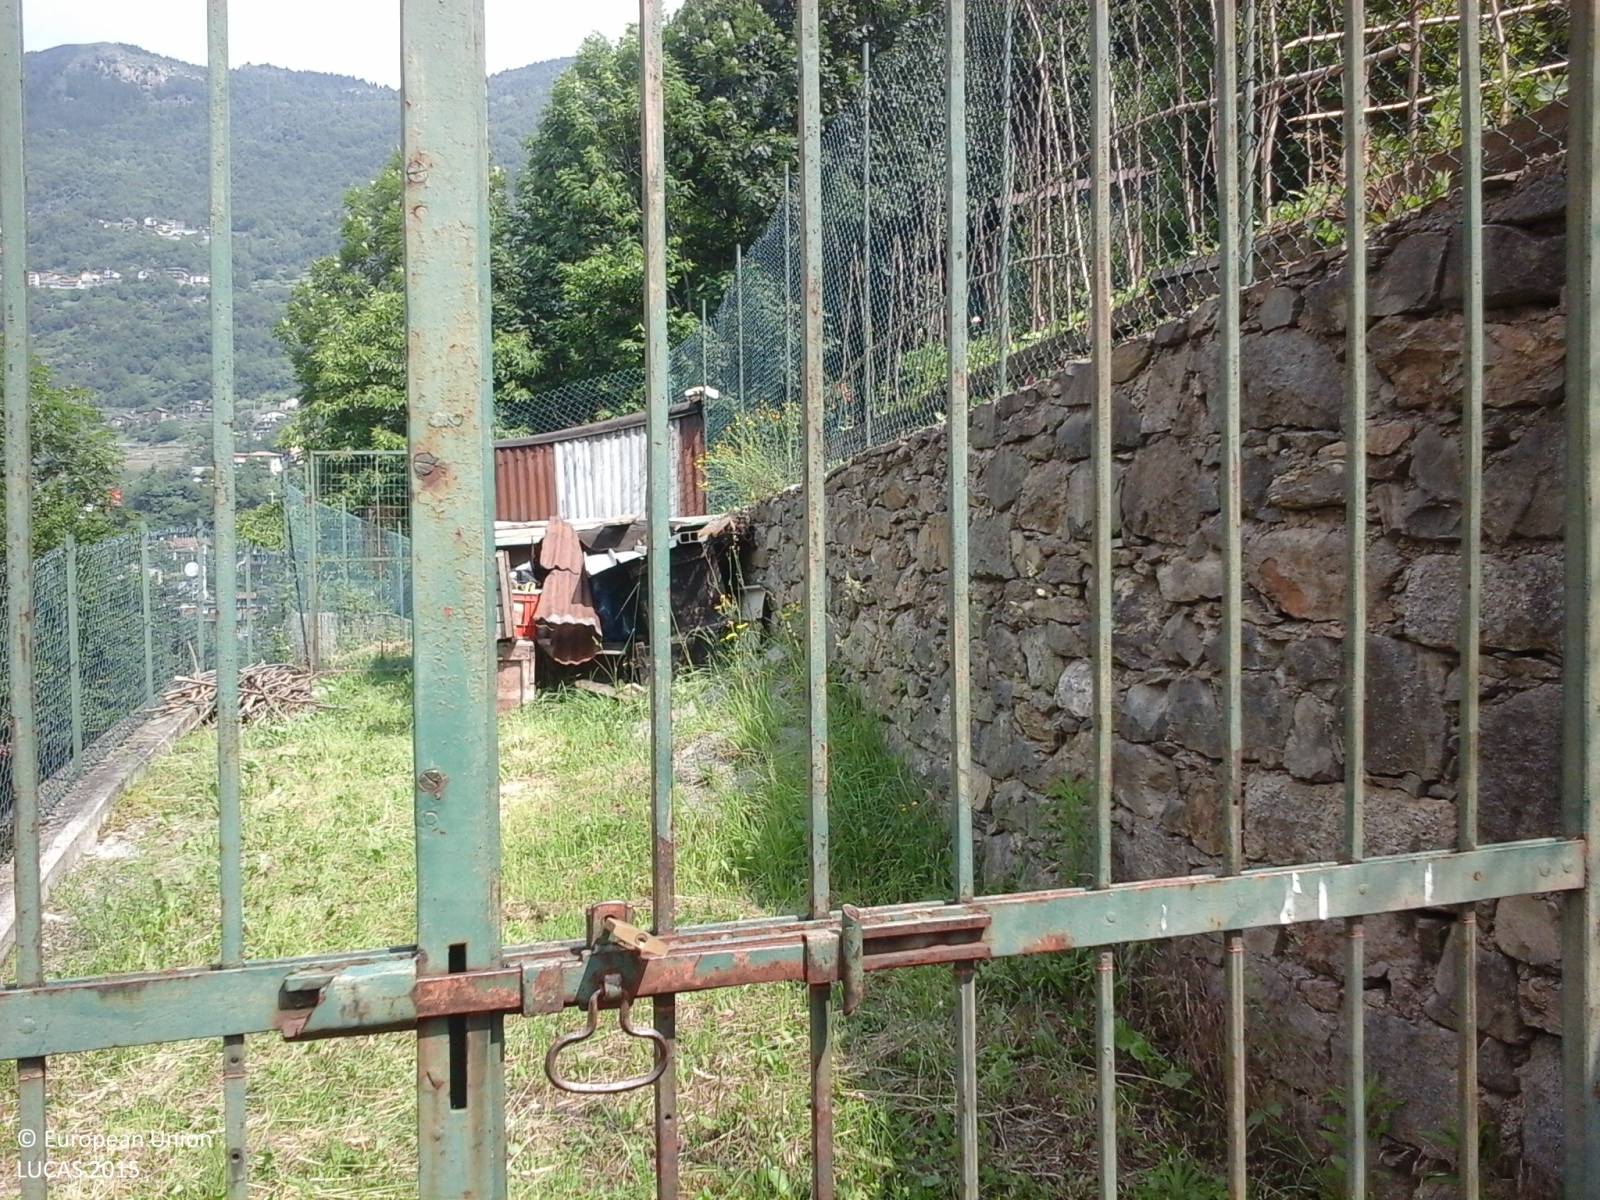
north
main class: Cropland
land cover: Tomatoes
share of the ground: 25 - 50 %
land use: Kitchen garden
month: June
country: IT
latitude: 46.0804
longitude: 10.3486
